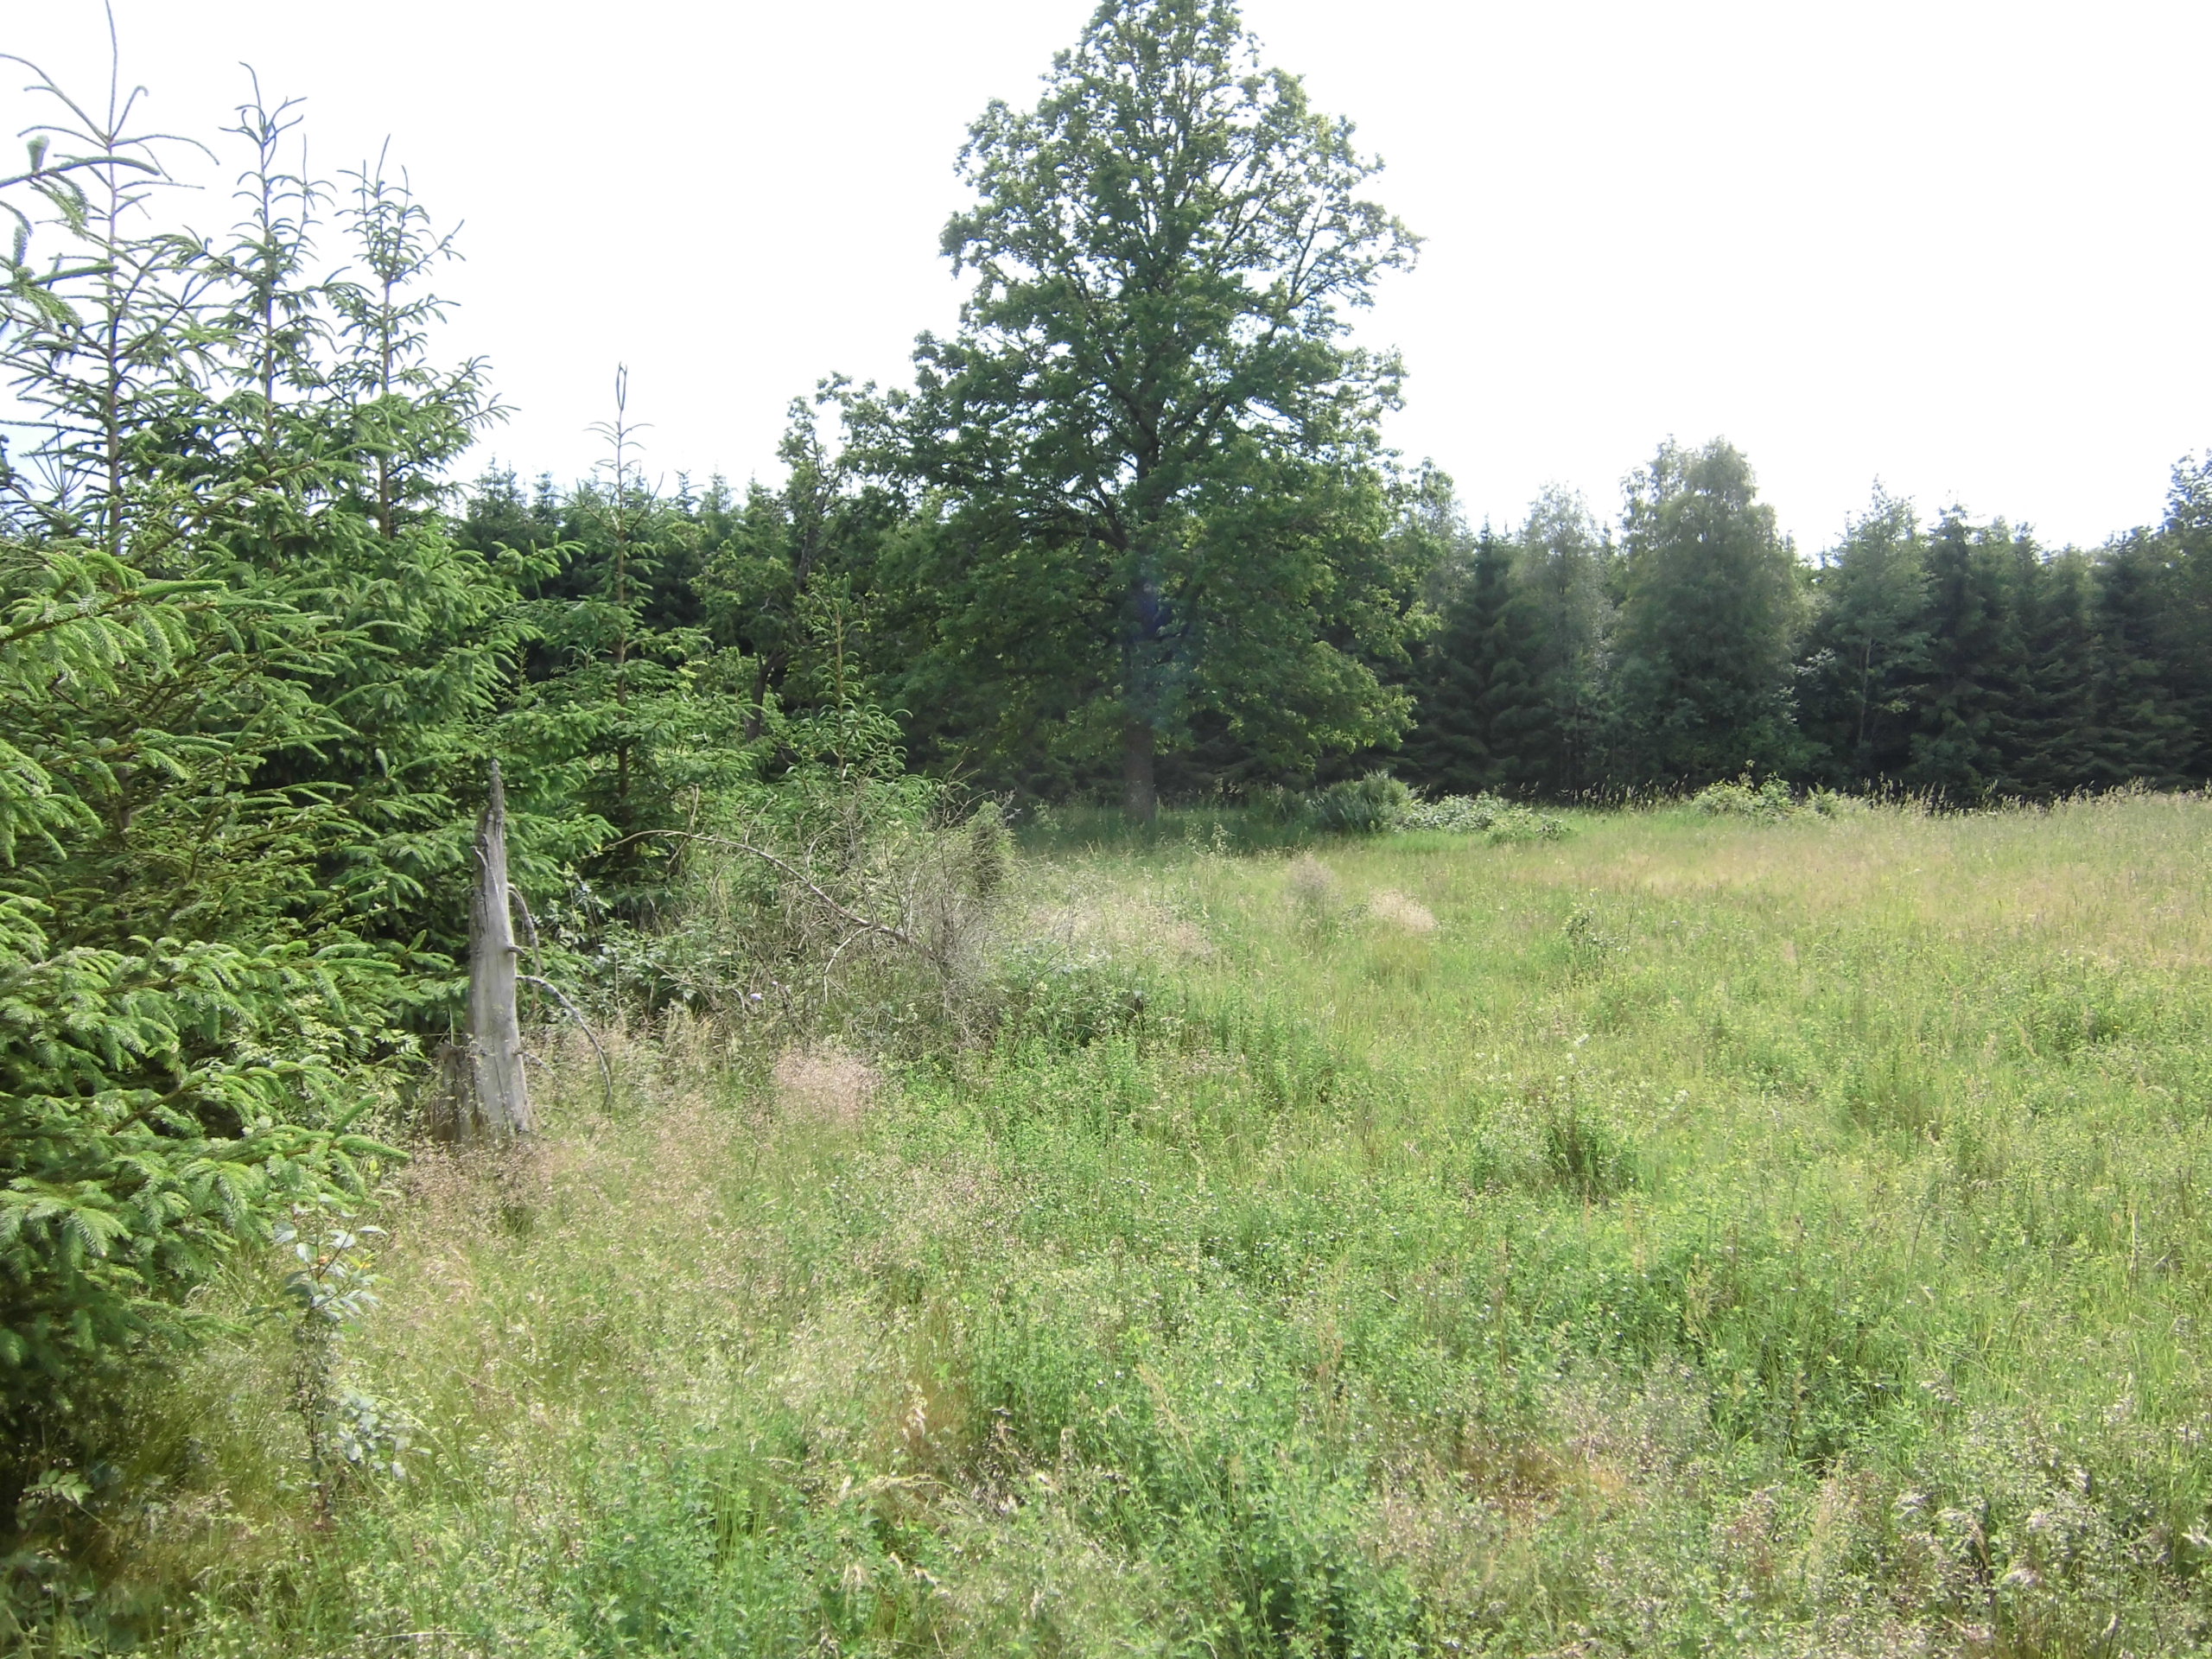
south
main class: Woodland
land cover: Spruce dominated coniferous woodland
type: boreal forest
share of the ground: 50 - 75 %
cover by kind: coniferous forest trees 50 %, herbaceous plants 35 %, broadleaved forest trees 5 %, shrubs 5 %, lichens and mosses 5 %
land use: Forestry
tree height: < 5 m
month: July
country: SE
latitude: 57.2966
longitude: 14.5265
